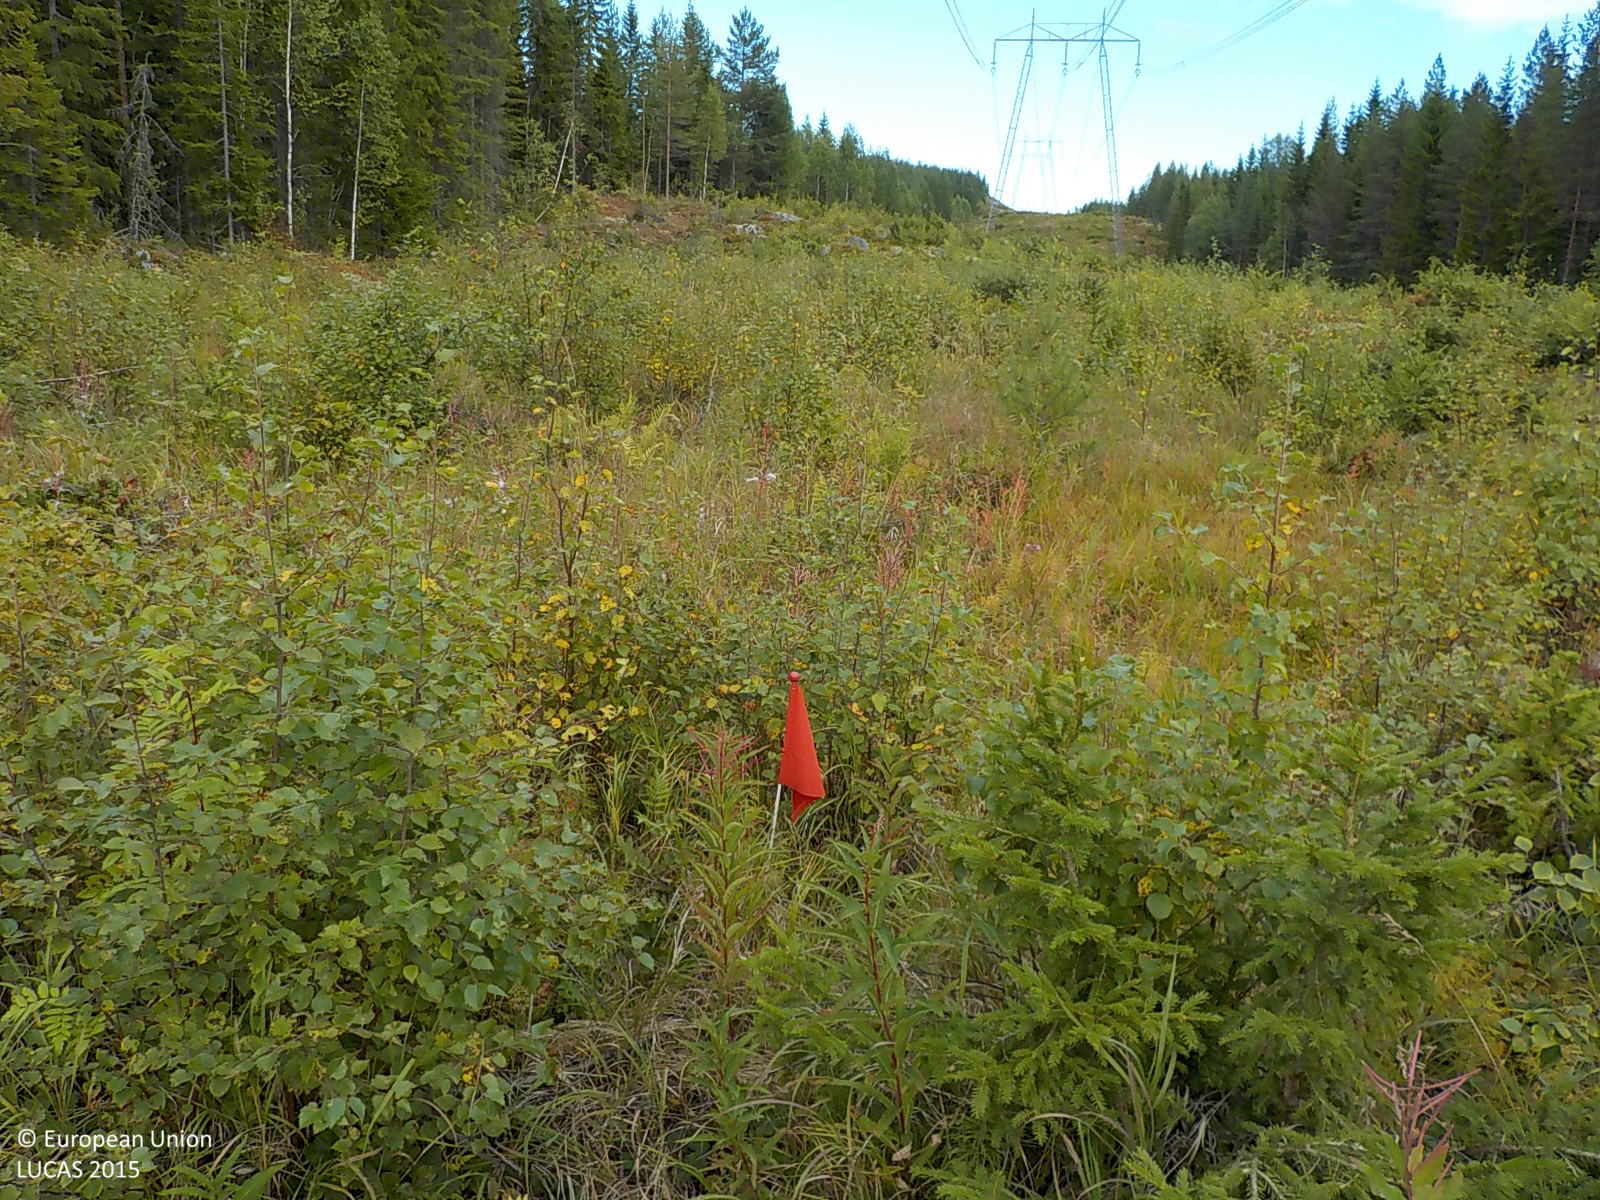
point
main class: Artificial land
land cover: Other artificial areas
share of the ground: 50 - 75 %
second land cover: Broadleaved woodland
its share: 25 - 50 %
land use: Electricity, gas and thermal power distribution
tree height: < 5 m
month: September
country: SE
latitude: 63.2841
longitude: 17.7314
